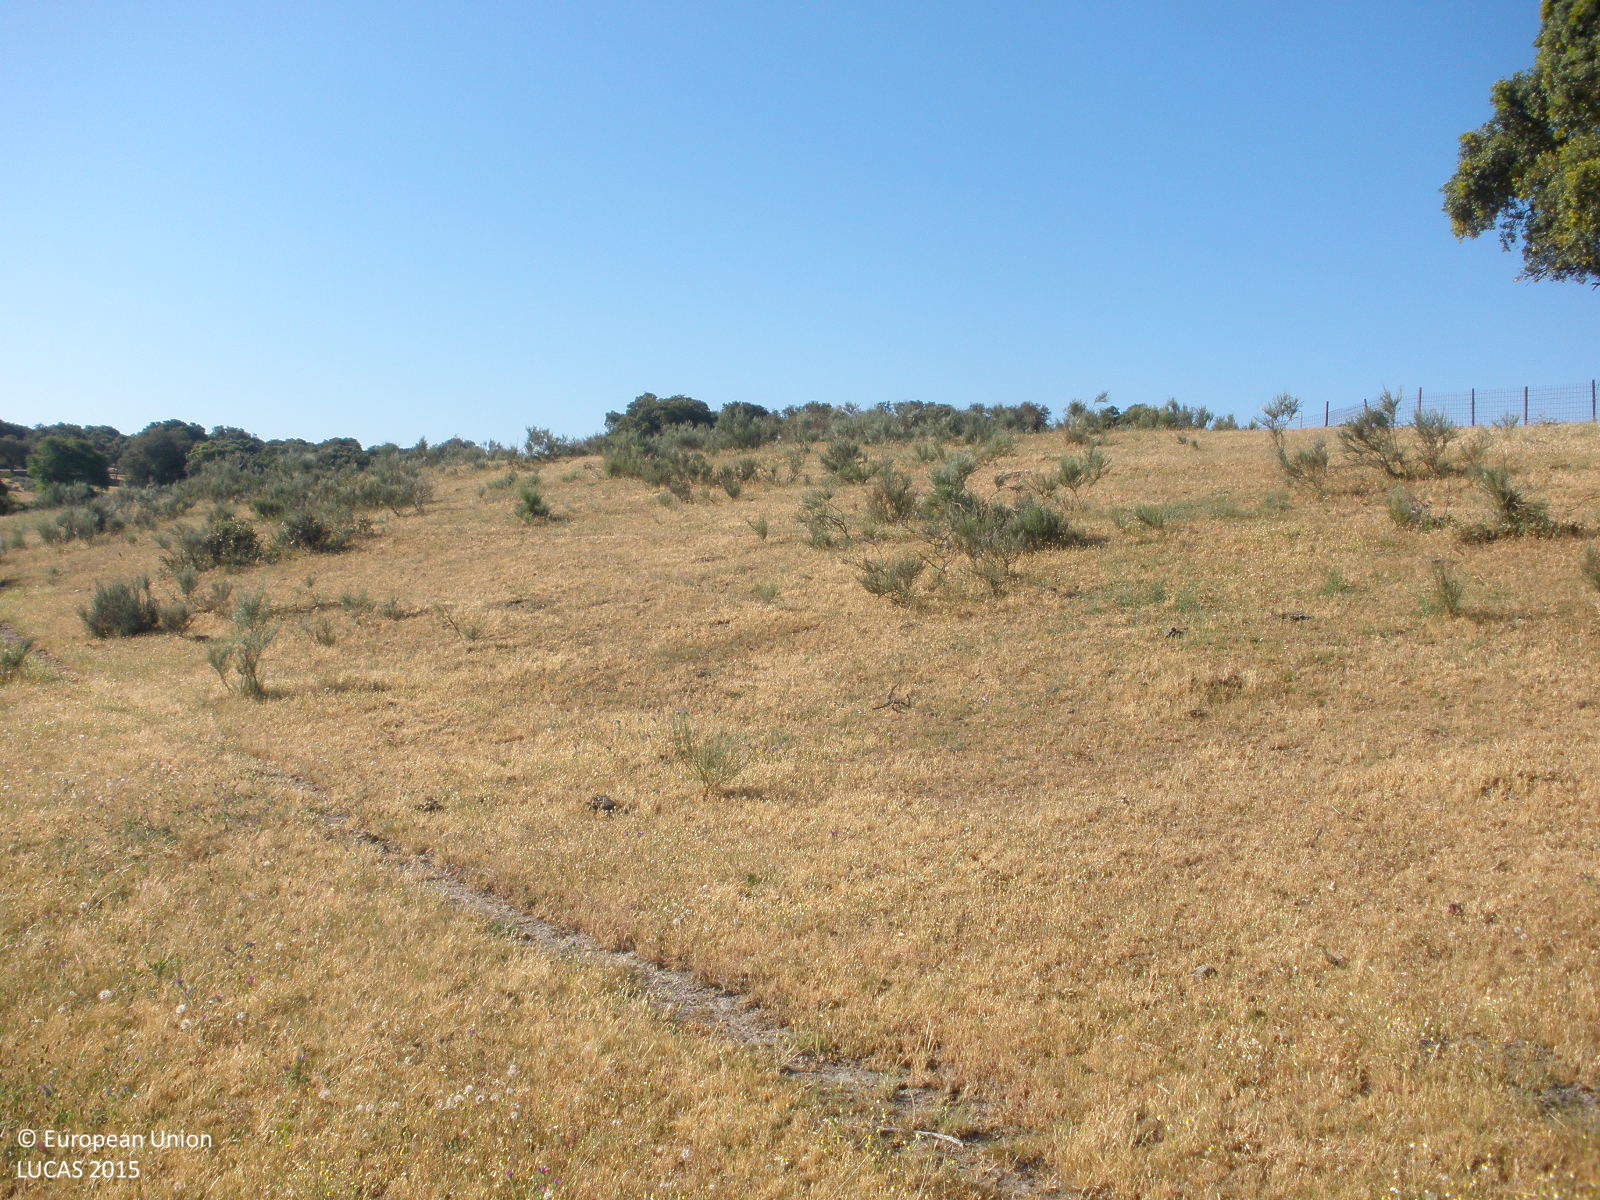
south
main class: Grassland
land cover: Grassland without tree/shrub cover
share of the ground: > 75 %
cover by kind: herbaceous plants 100 %
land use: Agriculture (excluding fallow land and kitchen gardens)
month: June
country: ES
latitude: 40.4572
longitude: -6.6344
